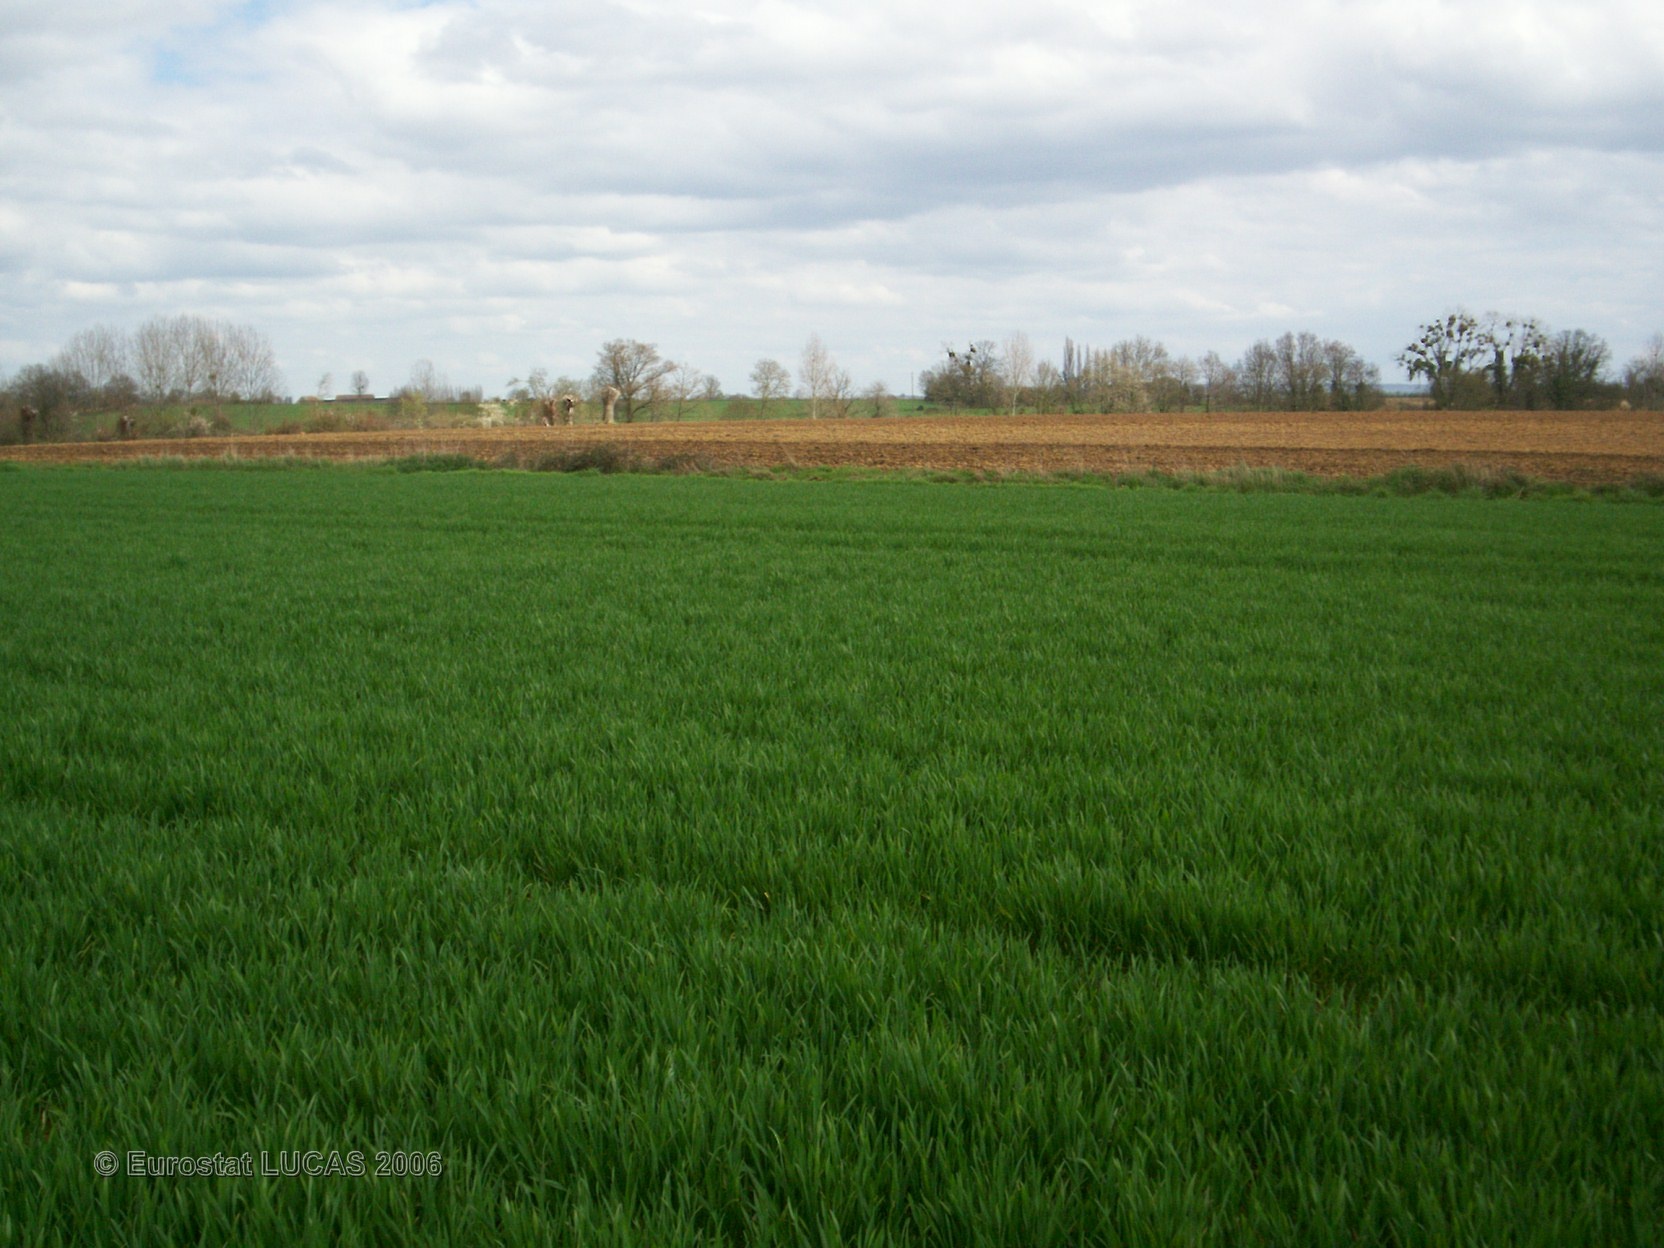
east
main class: Cropland
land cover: Common wheat
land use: Agriculture (excluding fallow land and kitchen gardens)
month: April
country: FR
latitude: 48.3053
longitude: 0.3345
